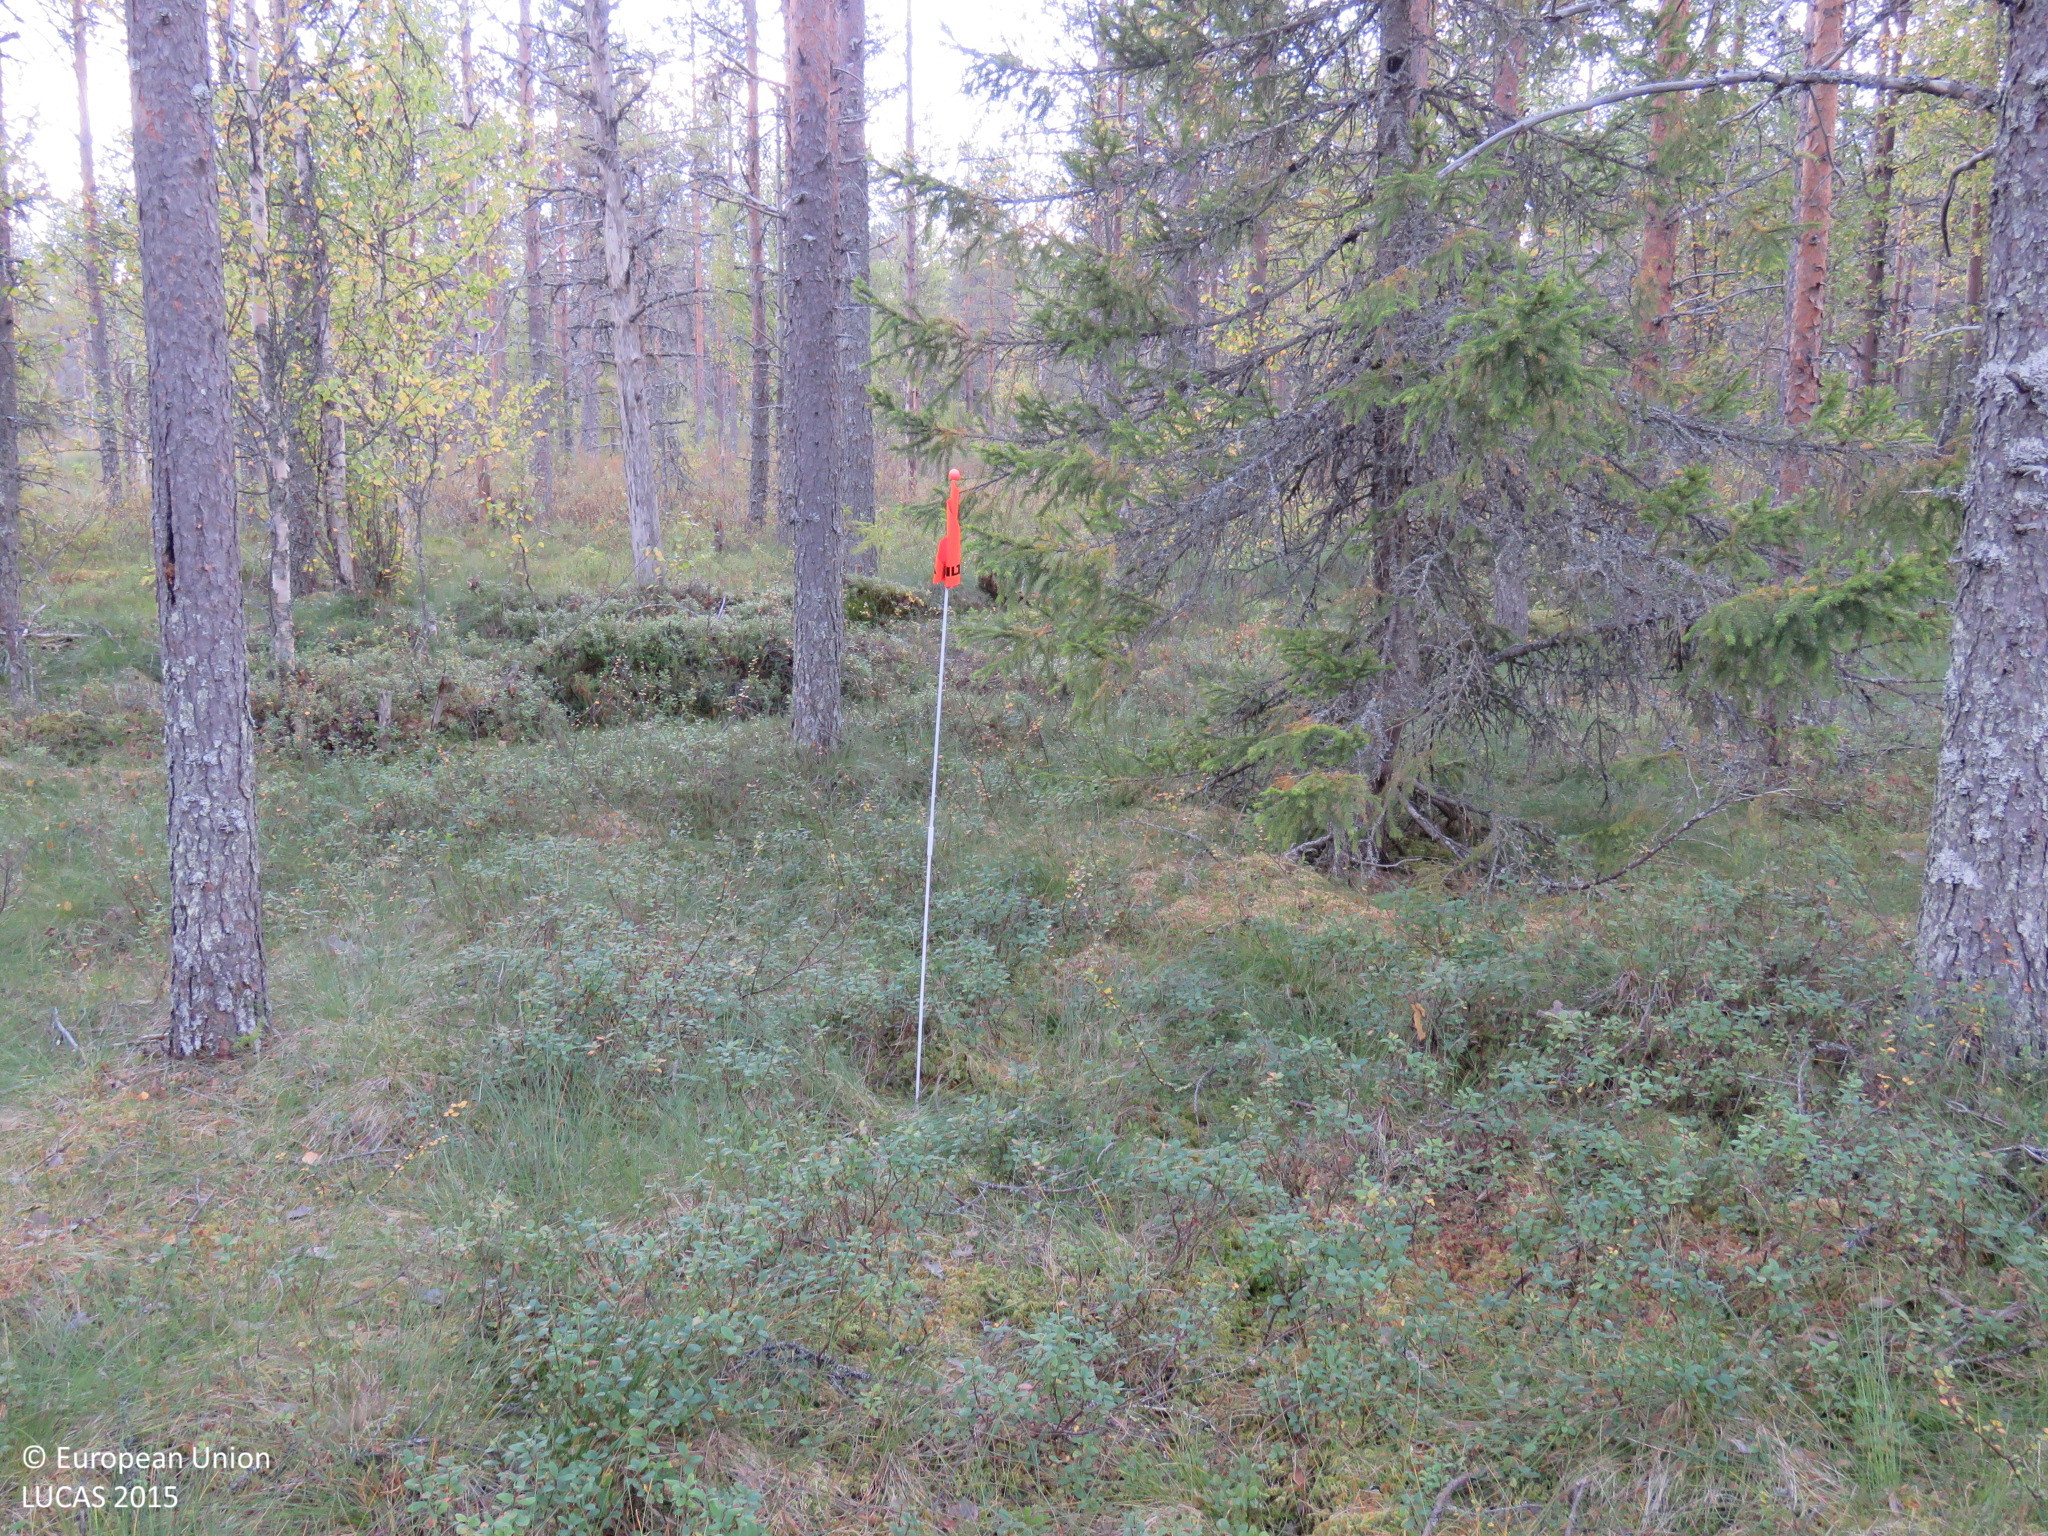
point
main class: Woodland
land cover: Pine dominated coniferous woodland
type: mire and swamp forests
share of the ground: > 75 %
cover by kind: coniferous forest trees 65 %, herbaceous plants 15 %, broadleaved forest trees 10 %, shrubs 5 %, lichens and mosses 5 %
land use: Forestry
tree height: > 5 m
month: September
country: FI
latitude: 65.3740
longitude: 27.6206
